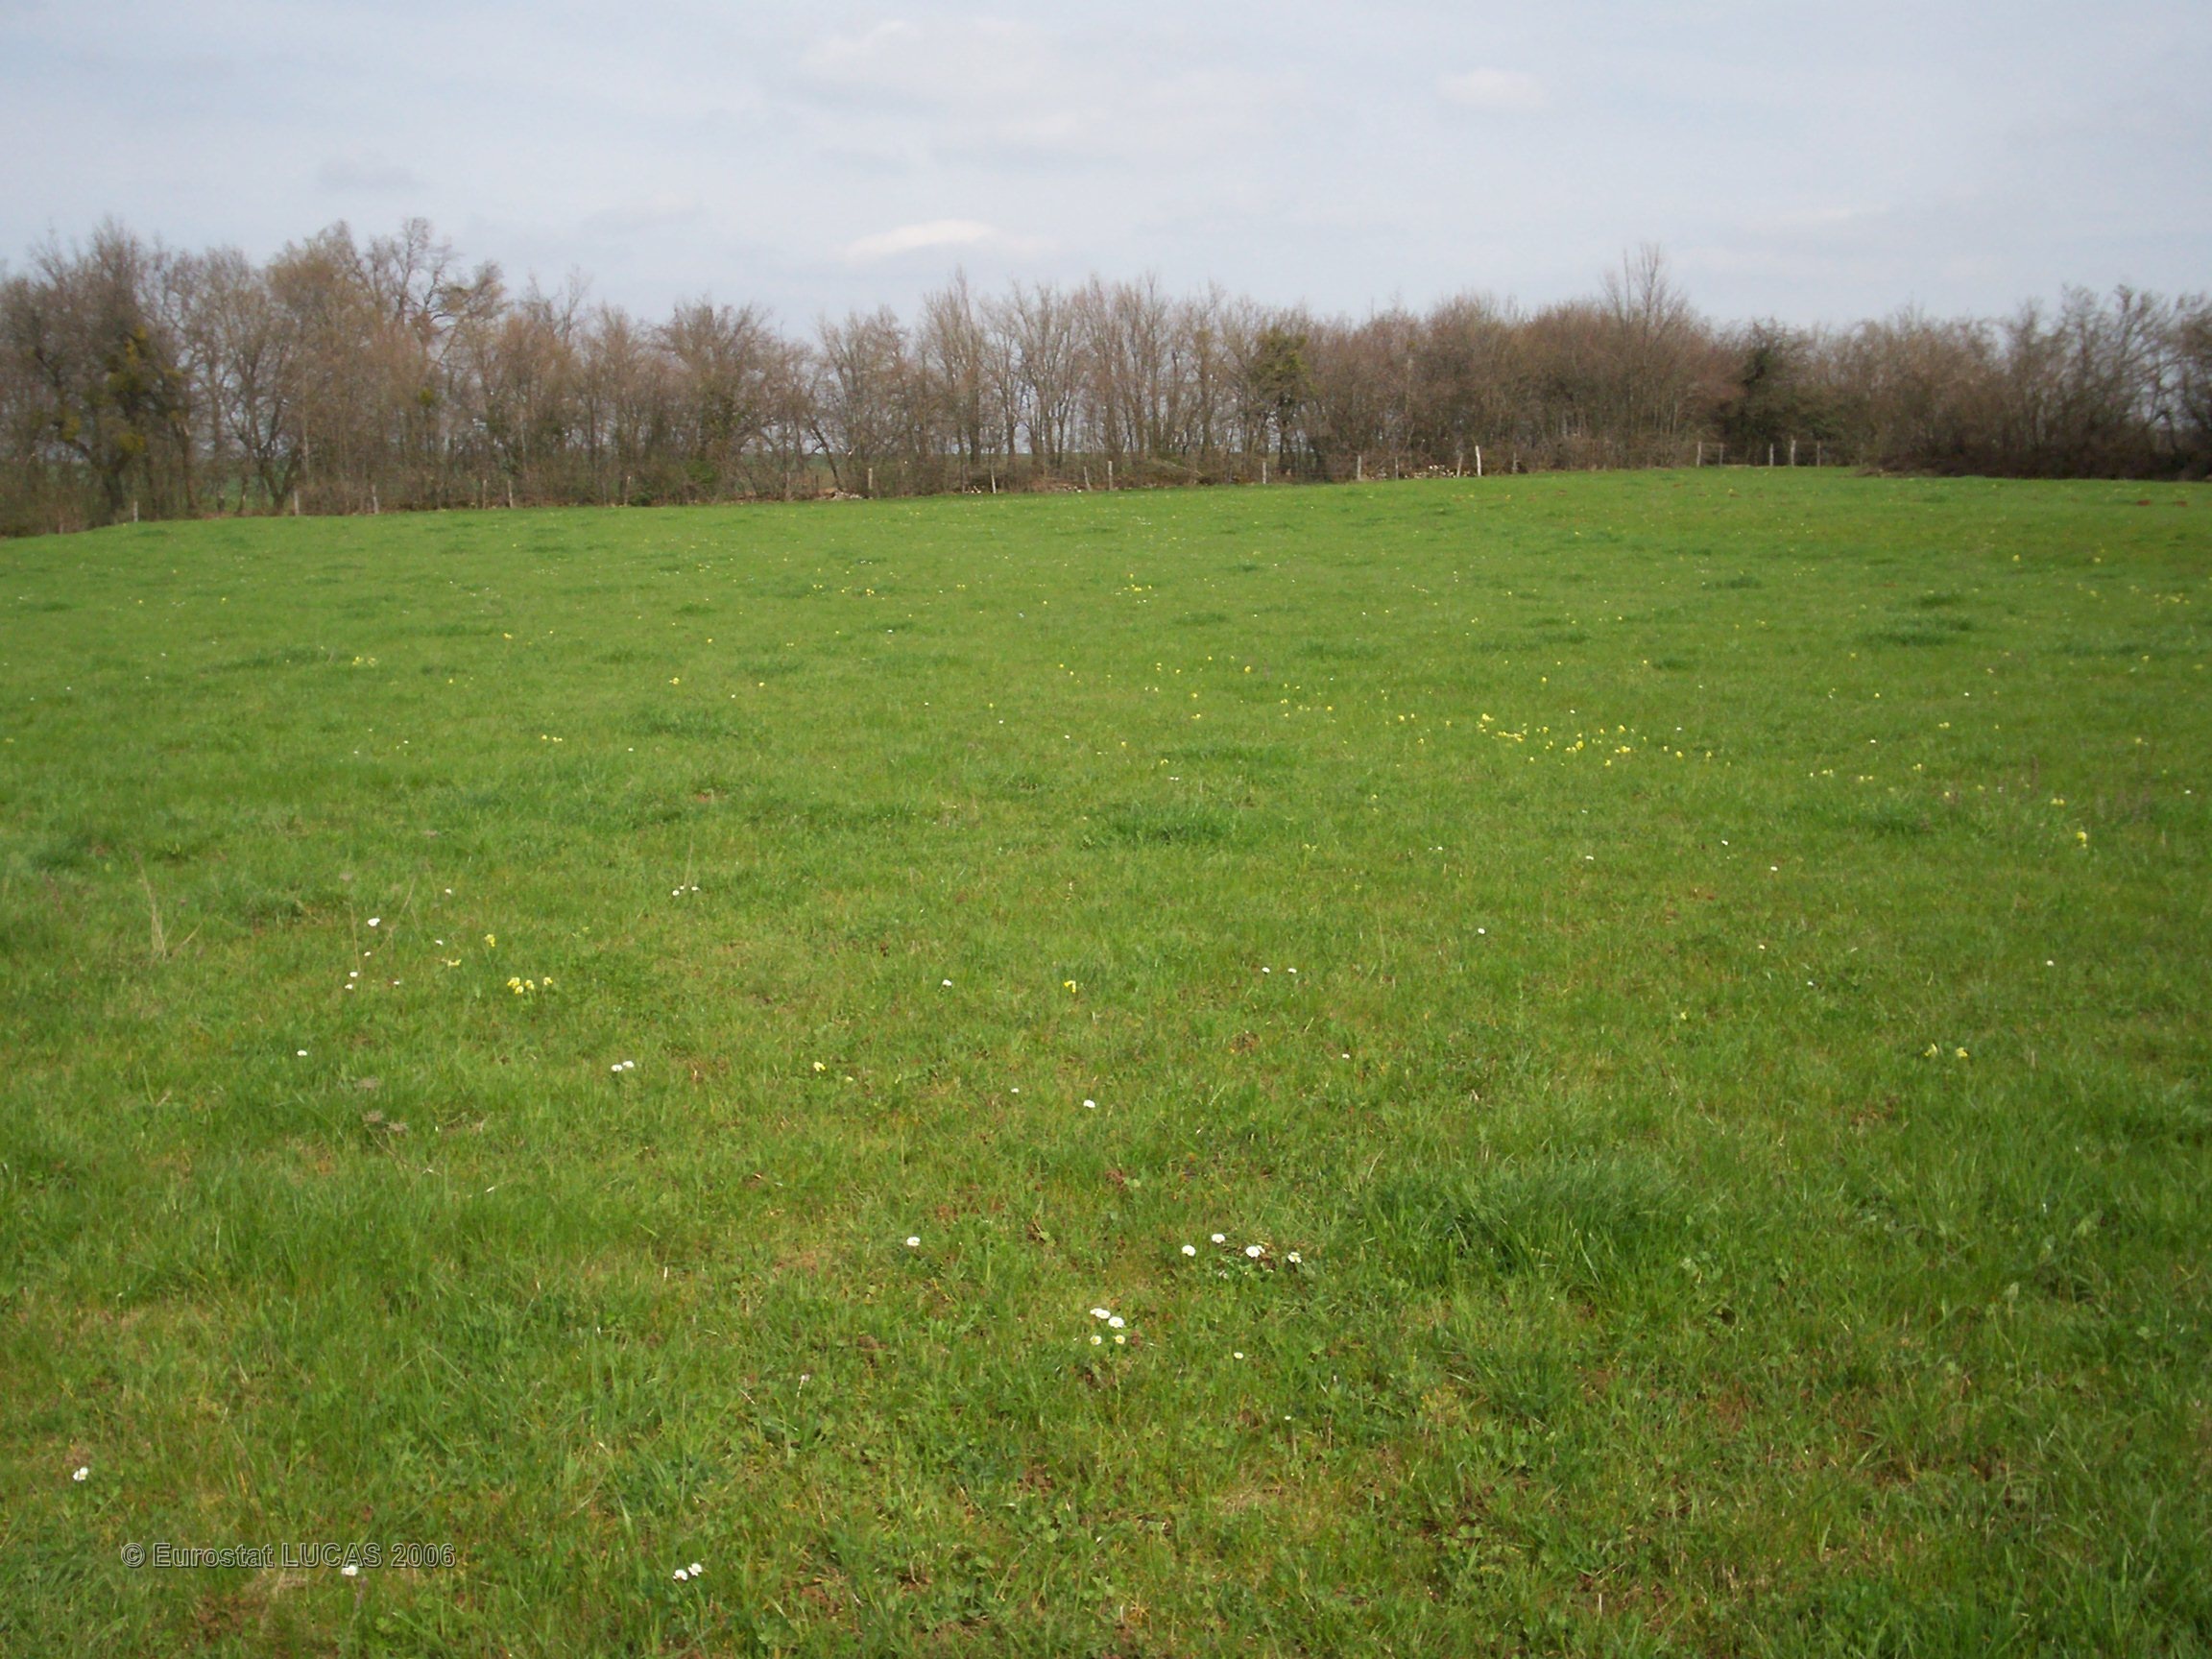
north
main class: Grassland
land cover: Grassland without tree/shrub cover
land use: Agriculture (excluding fallow land and kitchen gardens)
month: April
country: FR
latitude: 47.7983
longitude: 5.2872
